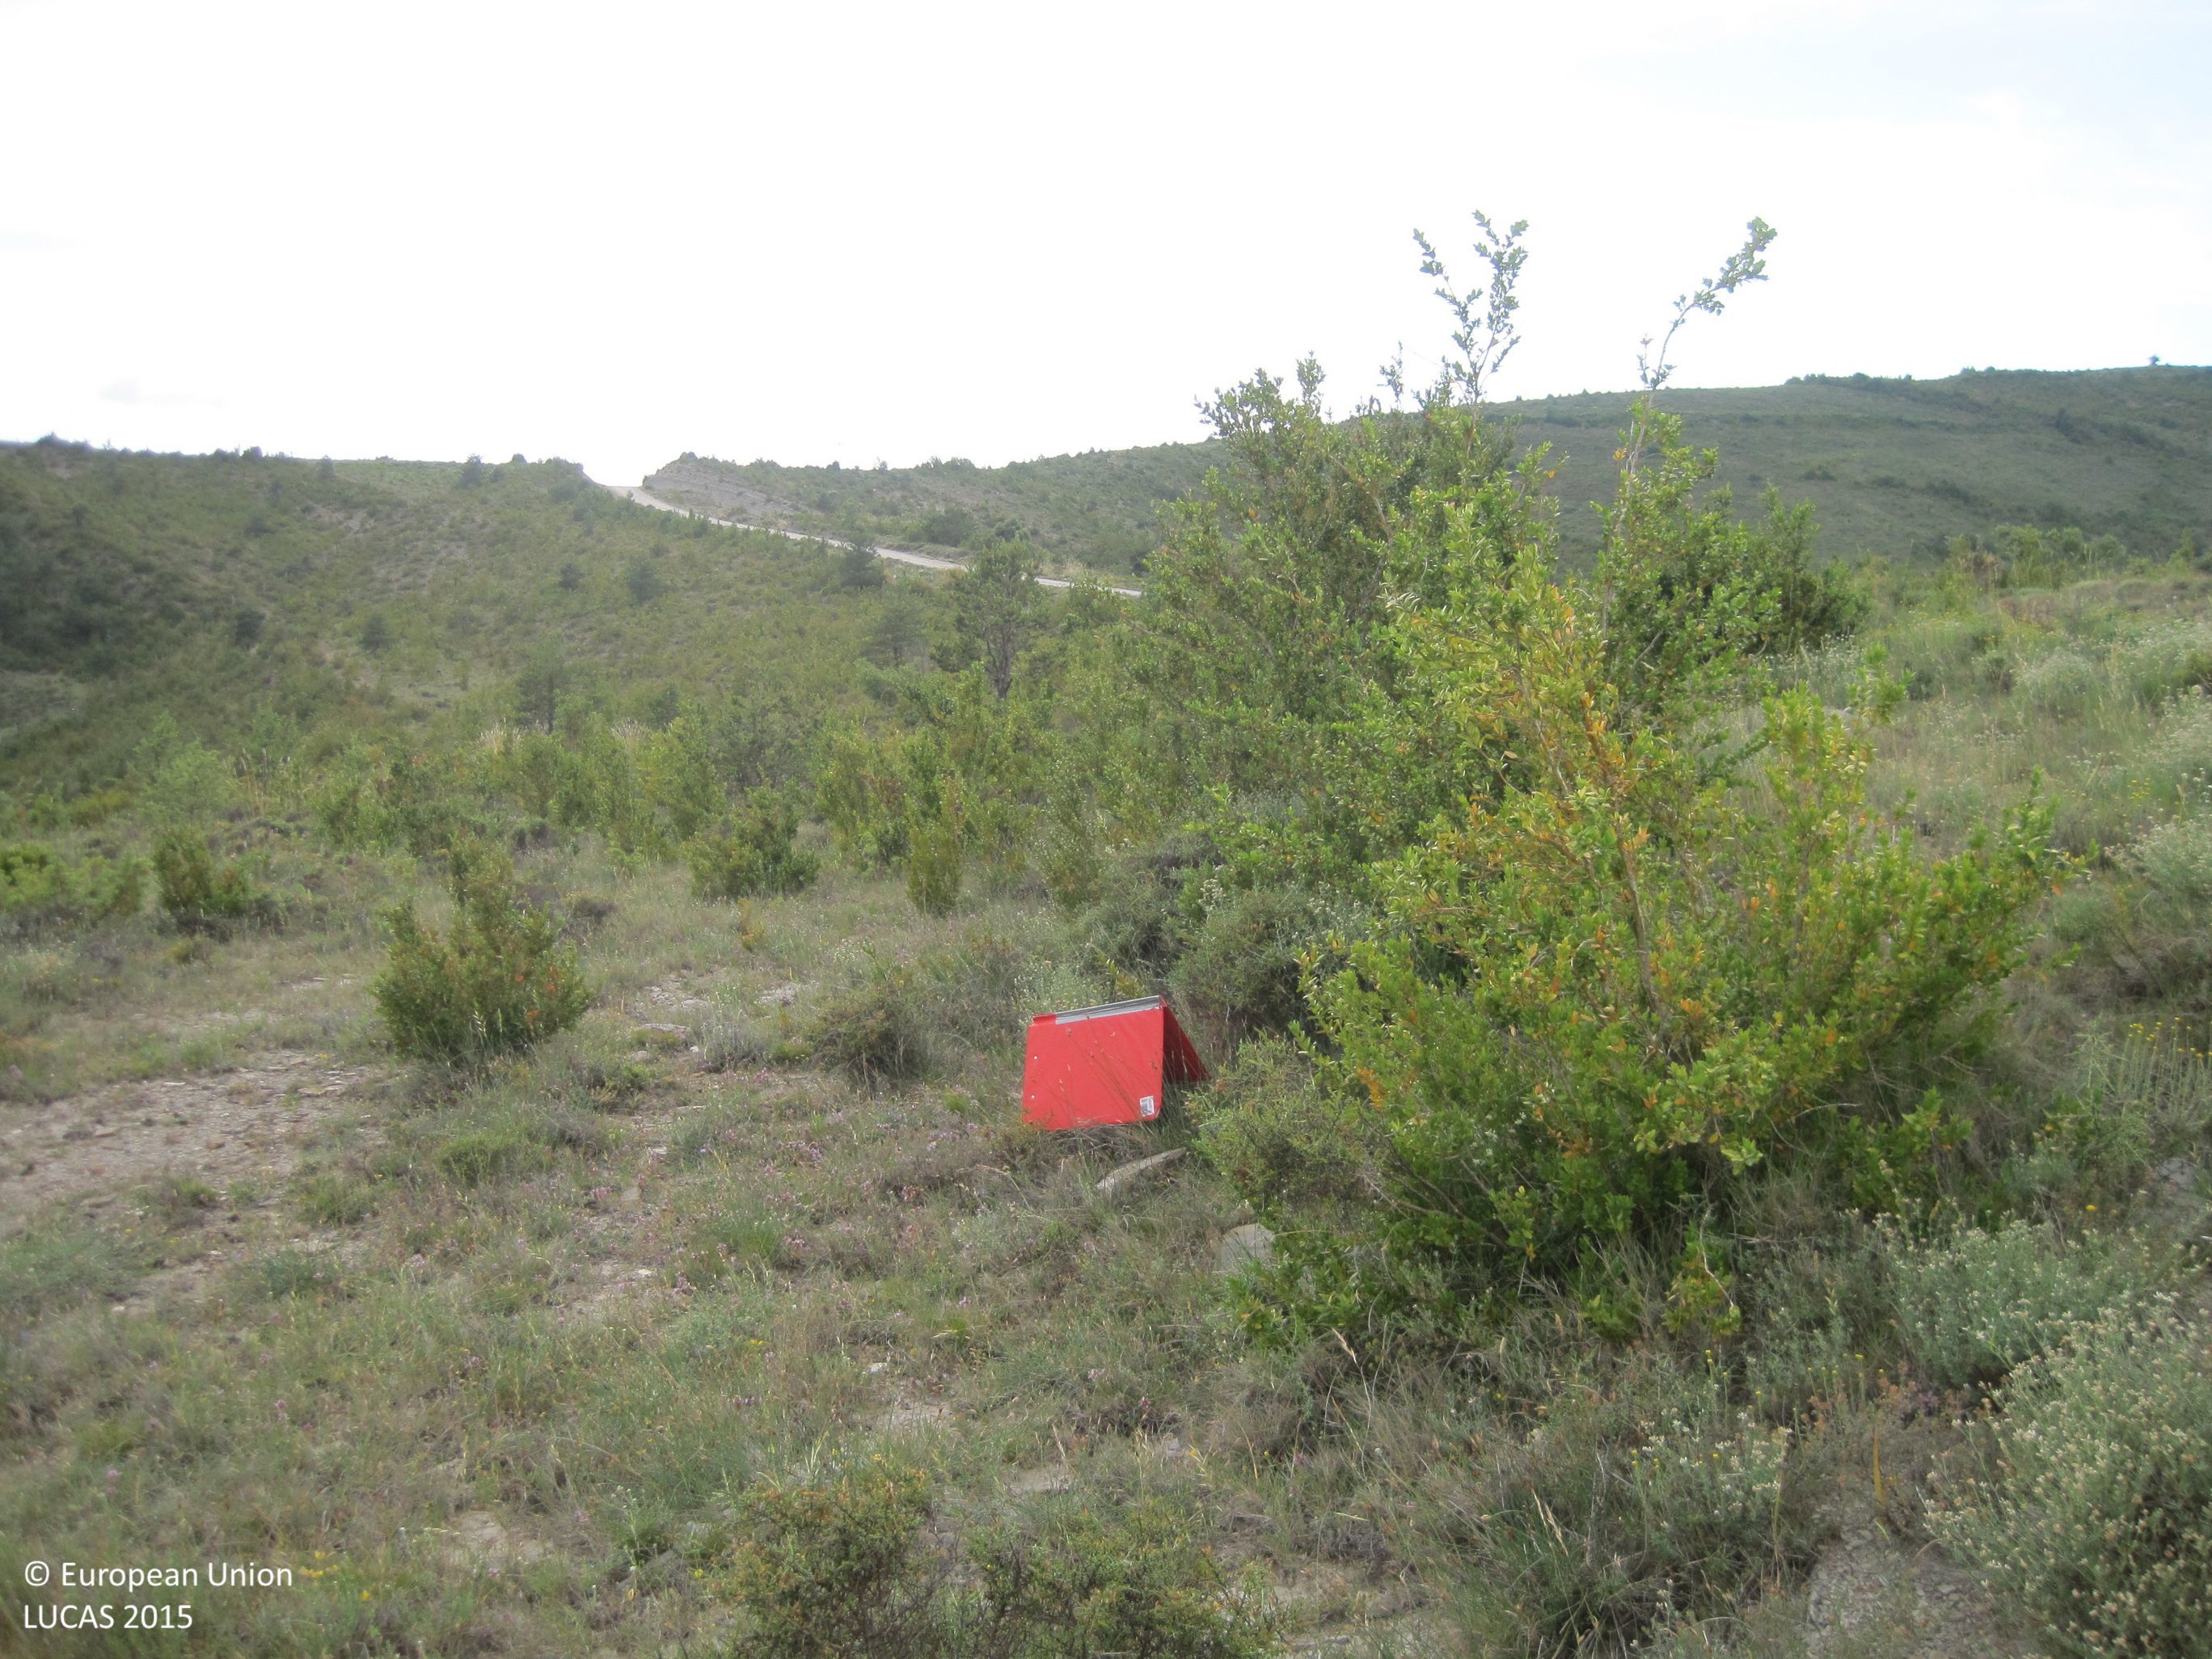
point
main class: Shrubland
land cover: Shrubland without tree cover
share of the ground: > 75 %
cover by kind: shrubs 40 %, herbaceous plants 30 %, consolidated bare surface 30 %
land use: Semi-natural and natural areas not in use
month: June
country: ES
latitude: 42.7274
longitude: -1.1595
